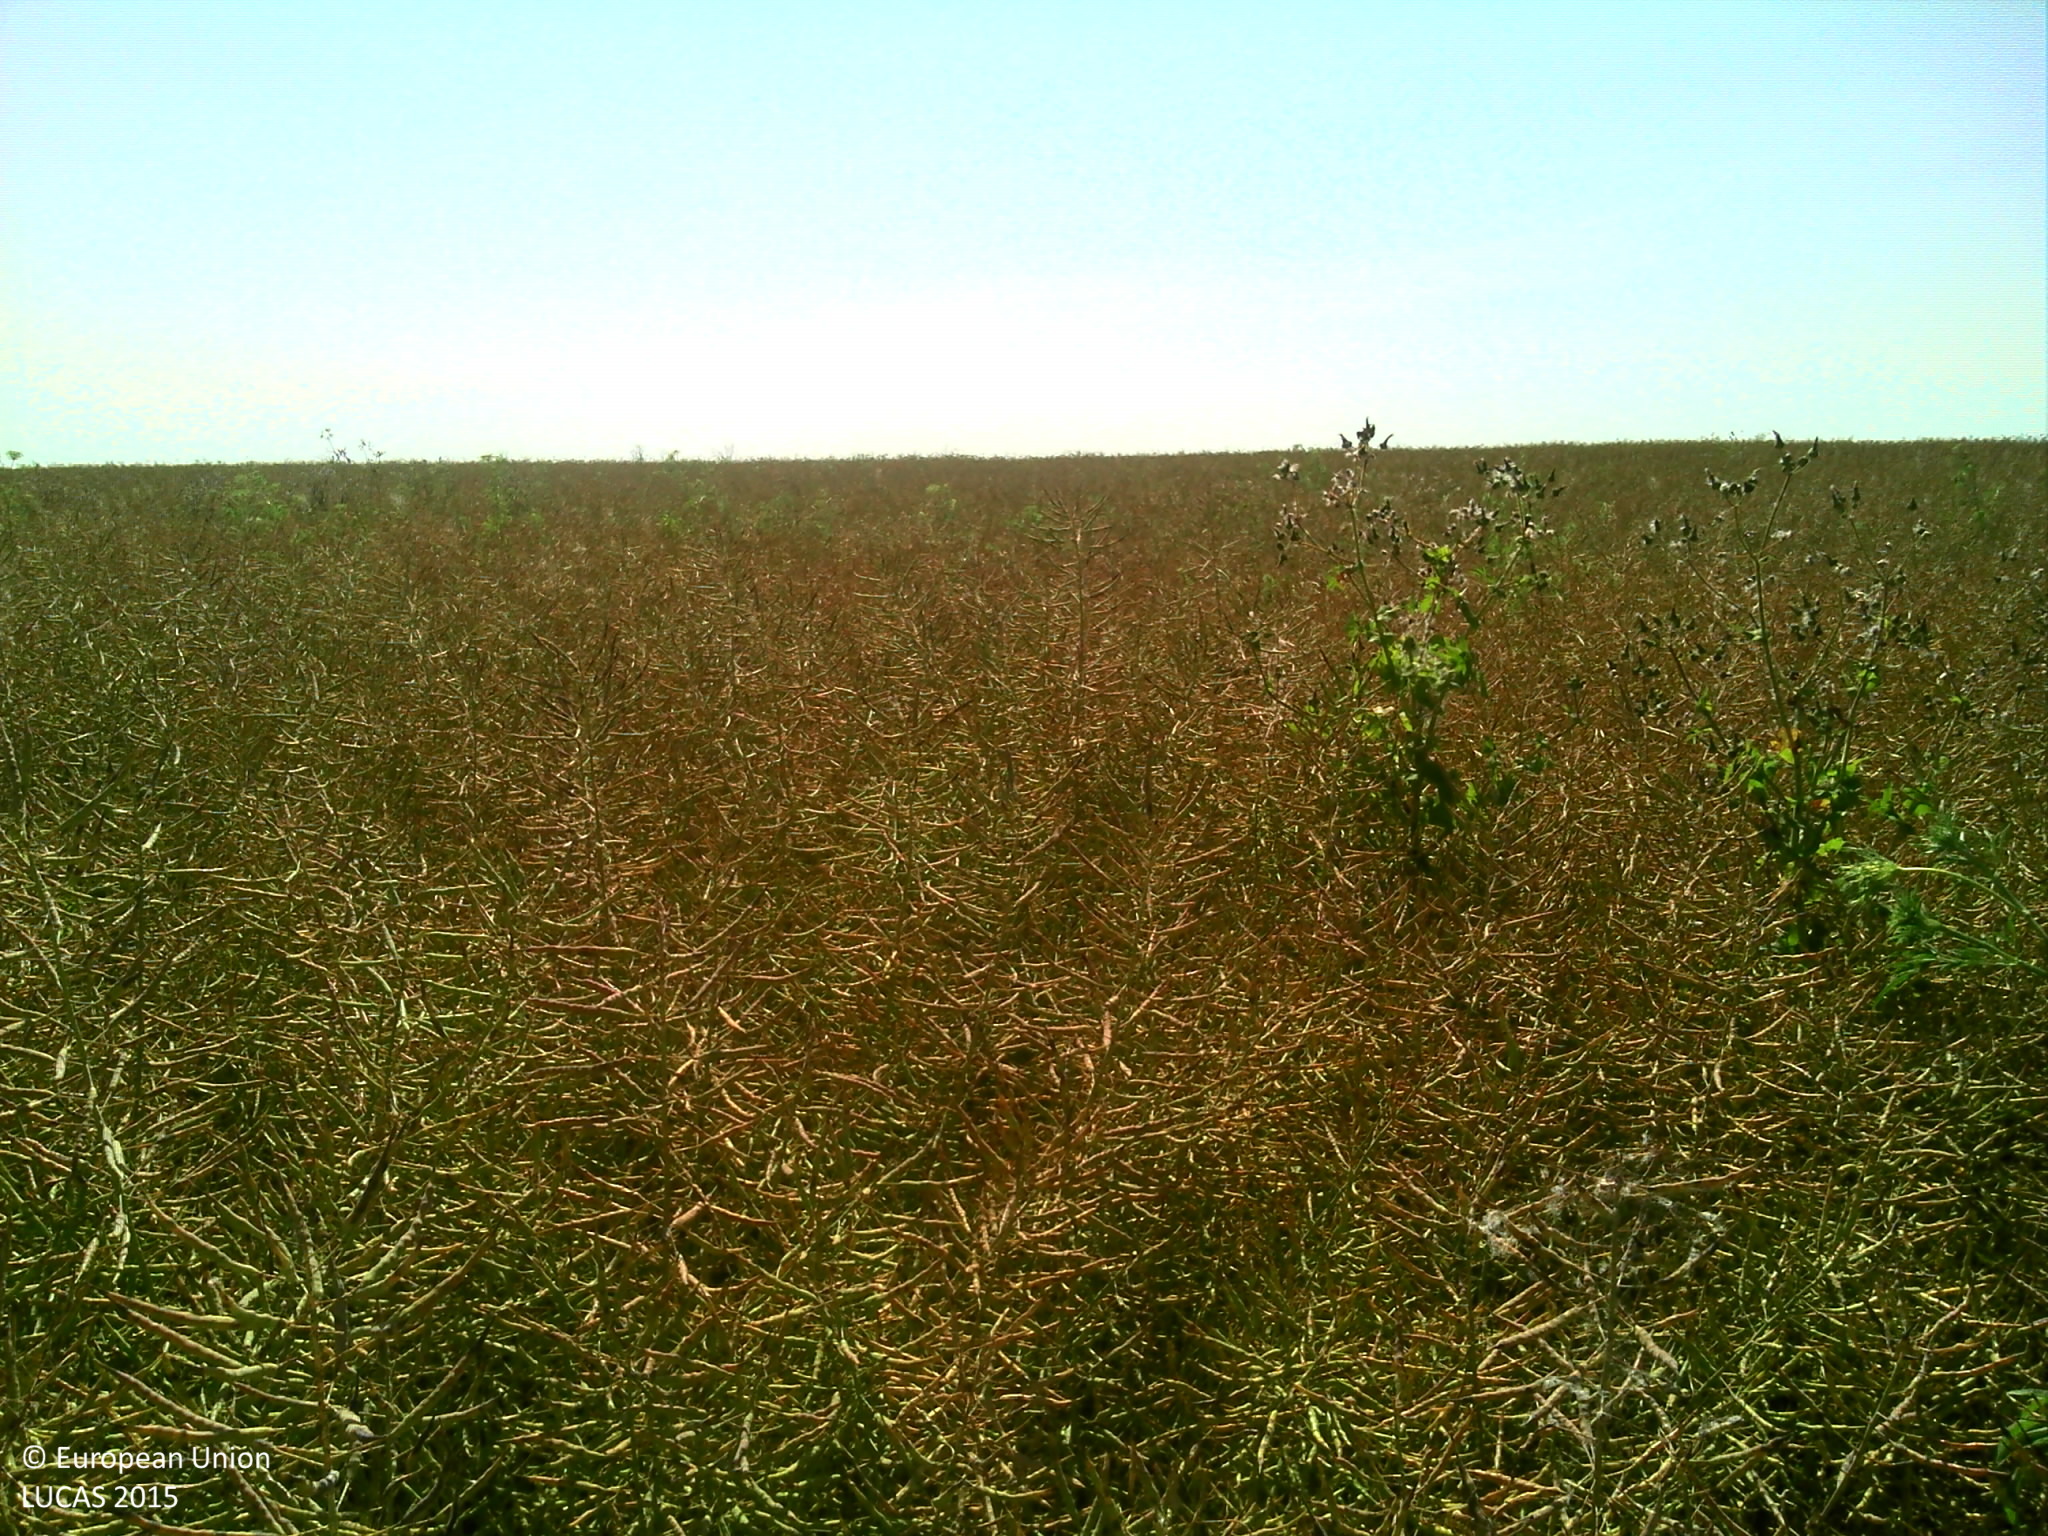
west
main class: Cropland
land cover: Rape and turnip rape
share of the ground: > 75 %
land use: Agriculture (excluding fallow land and kitchen gardens)
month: June
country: FR
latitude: 46.0748
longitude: -0.9811
